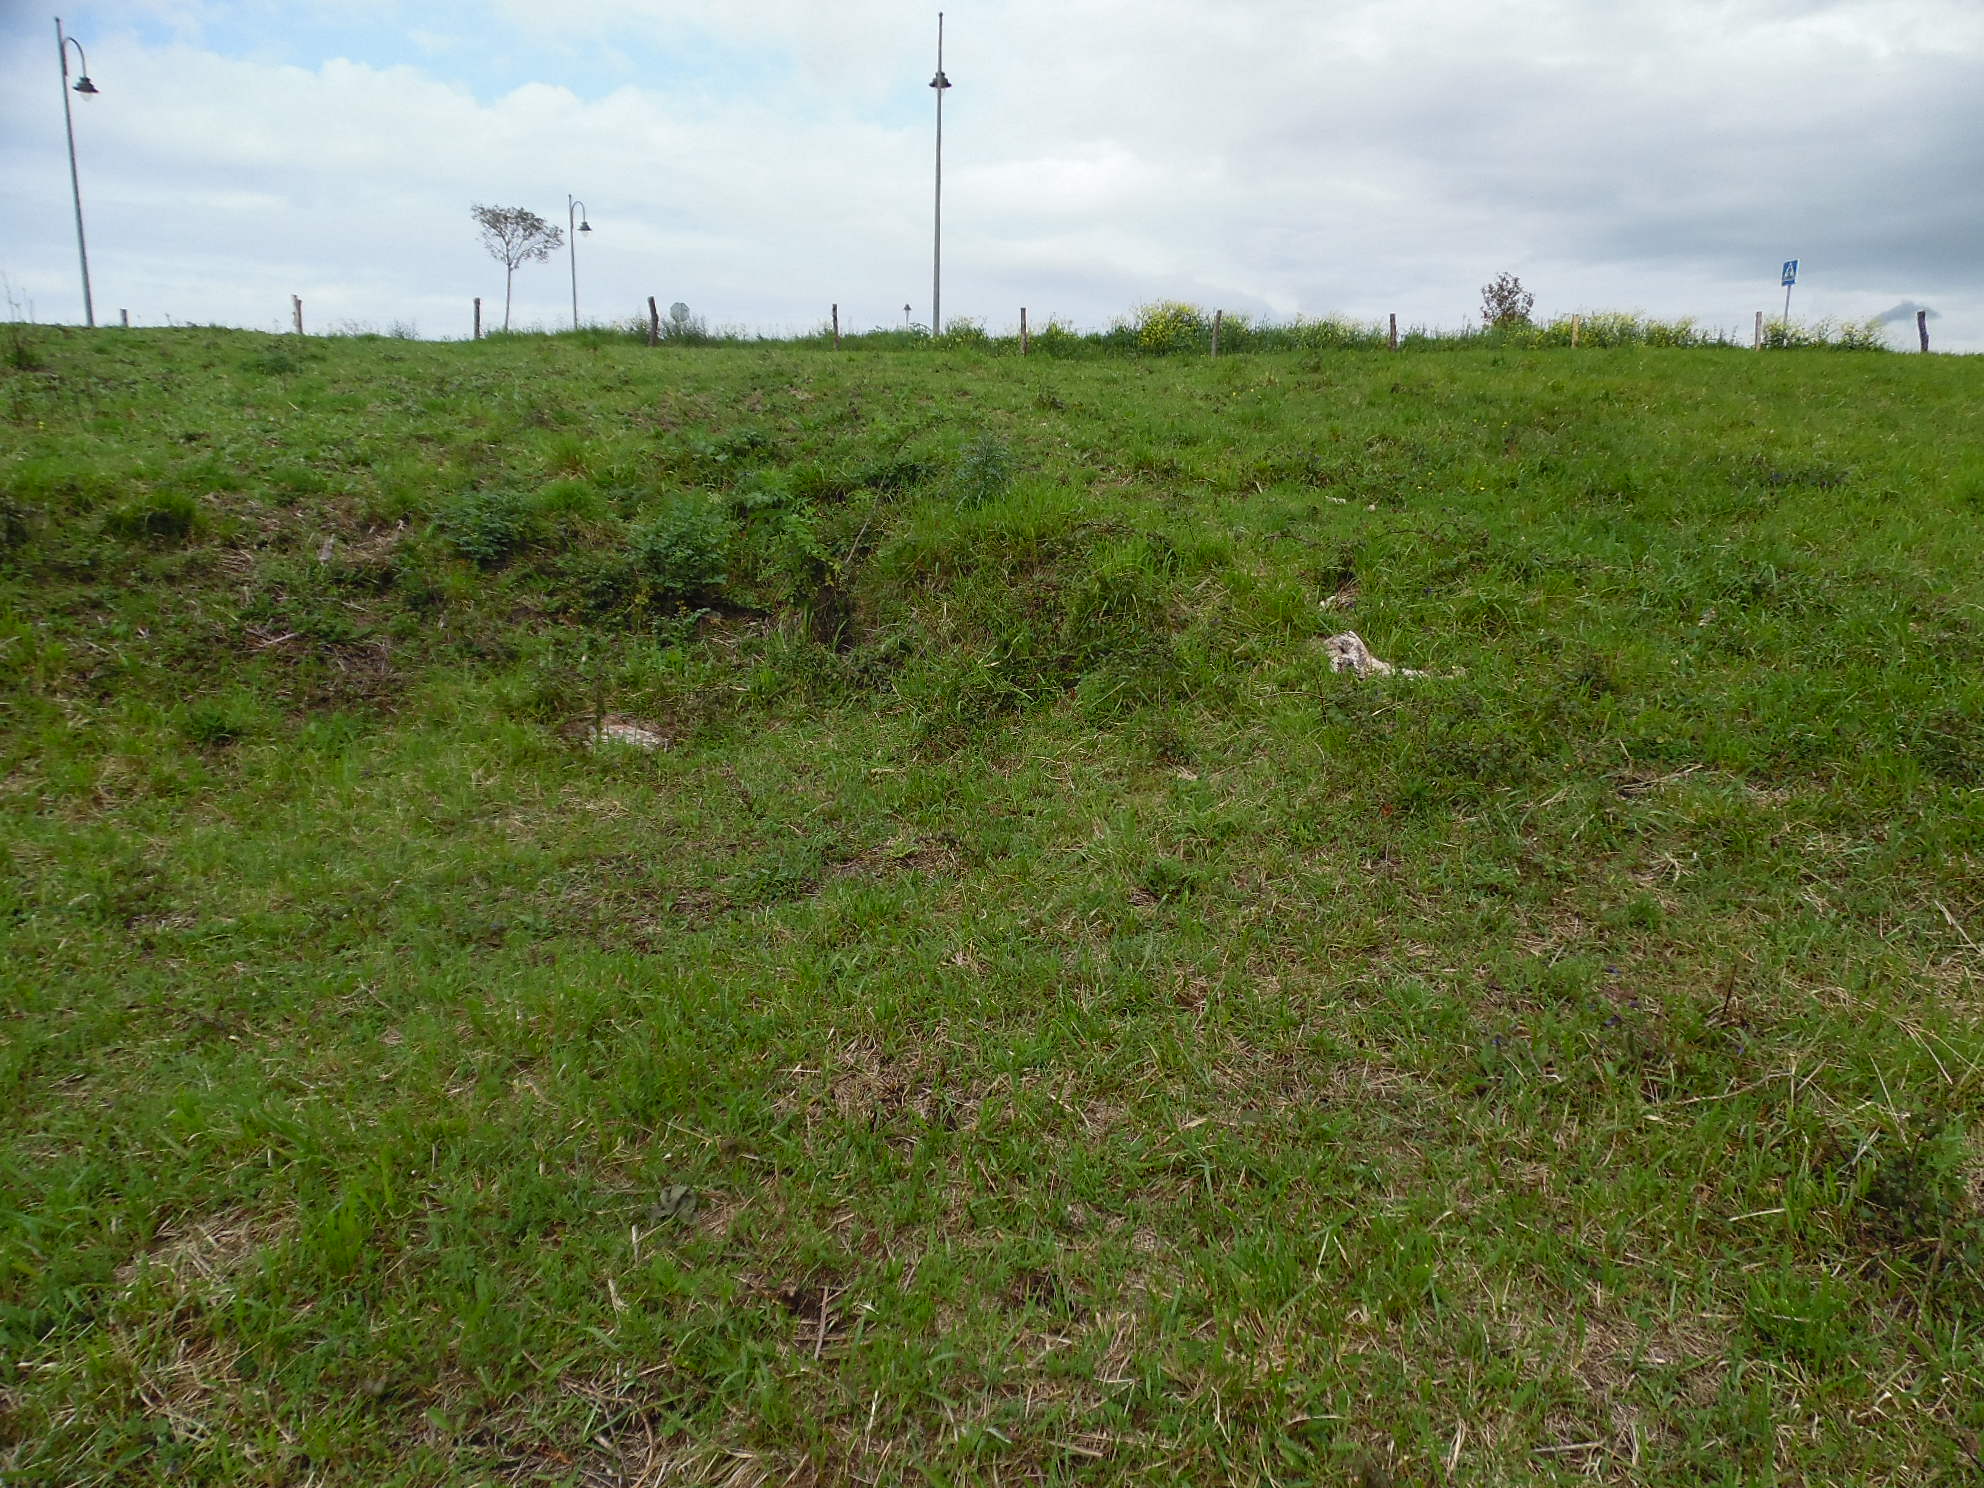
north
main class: Grassland
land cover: Grassland without tree/shrub cover
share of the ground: > 75 %
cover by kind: herbaceous plants 100 %
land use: Agriculture (excluding fallow land and kitchen gardens)
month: April
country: ES
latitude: 43.5383
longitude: -5.8940
